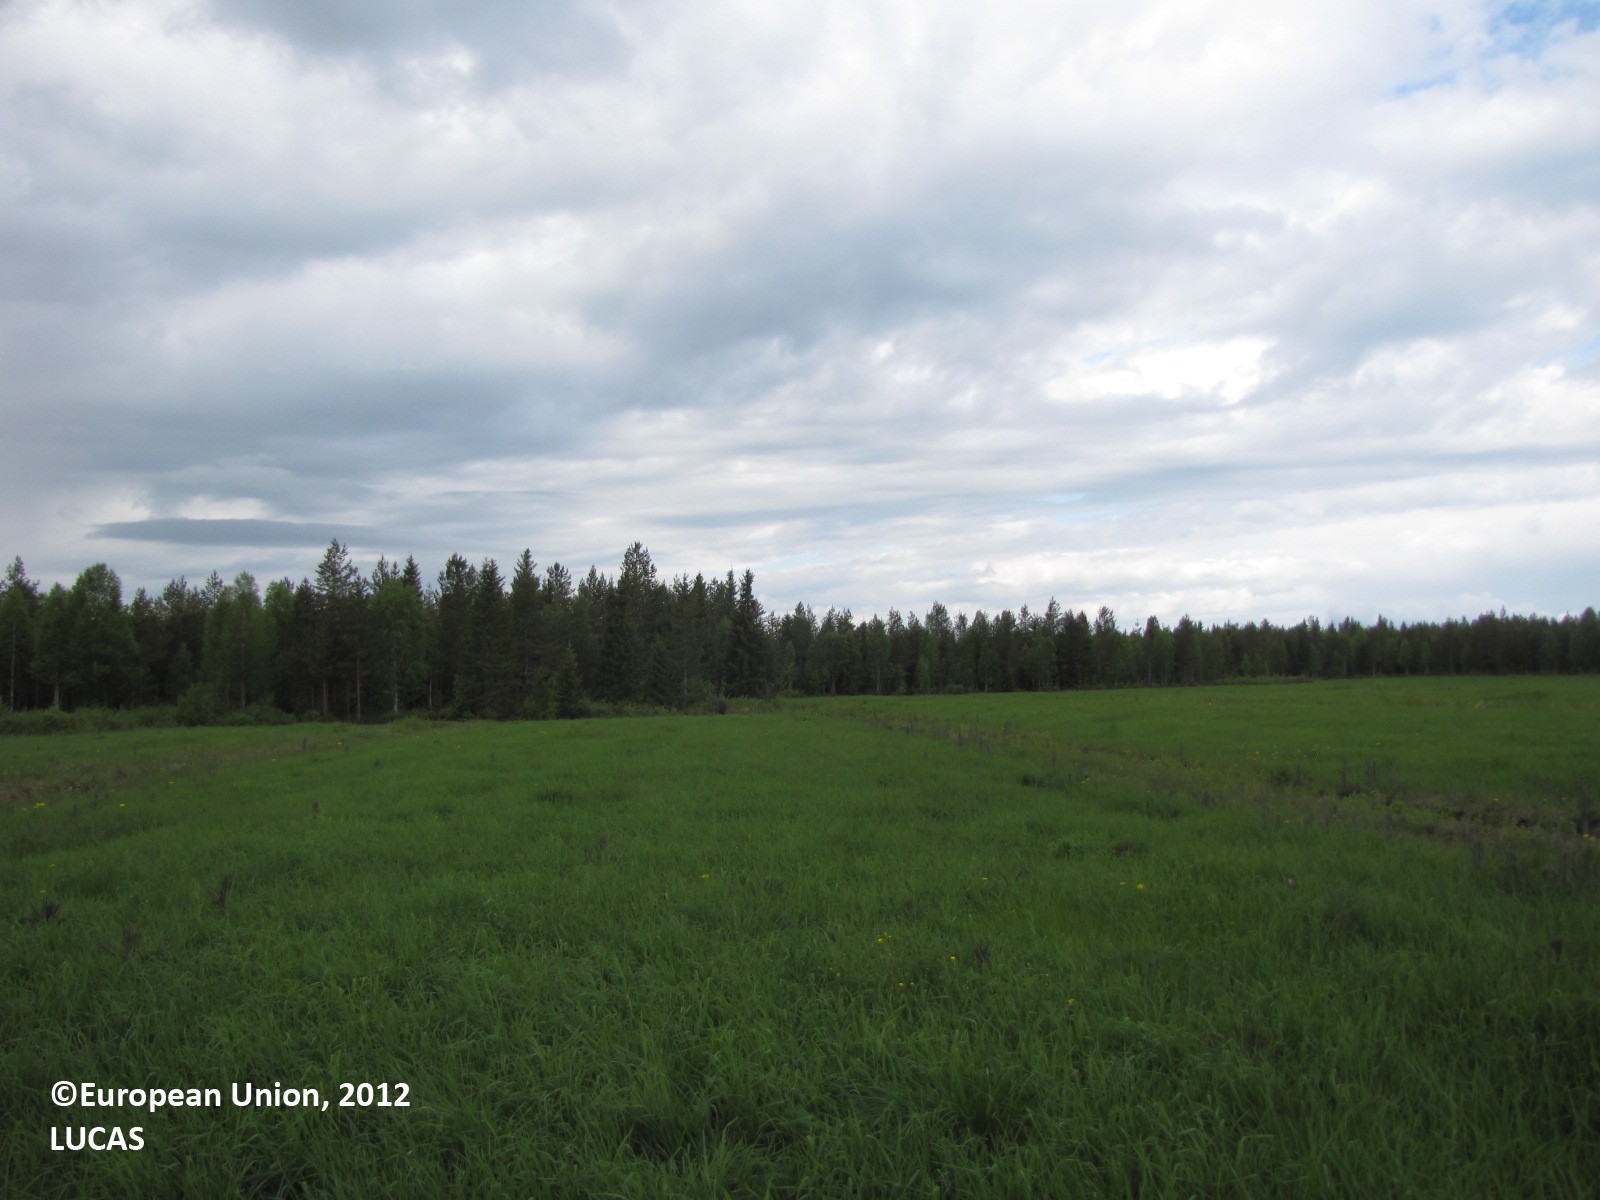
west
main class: Grassland
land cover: Grassland without tree/shrub cover
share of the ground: > 75 %
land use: Agriculture (excluding fallow land and kitchen gardens)
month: June
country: FI
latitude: 66.0910
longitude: 24.2640
